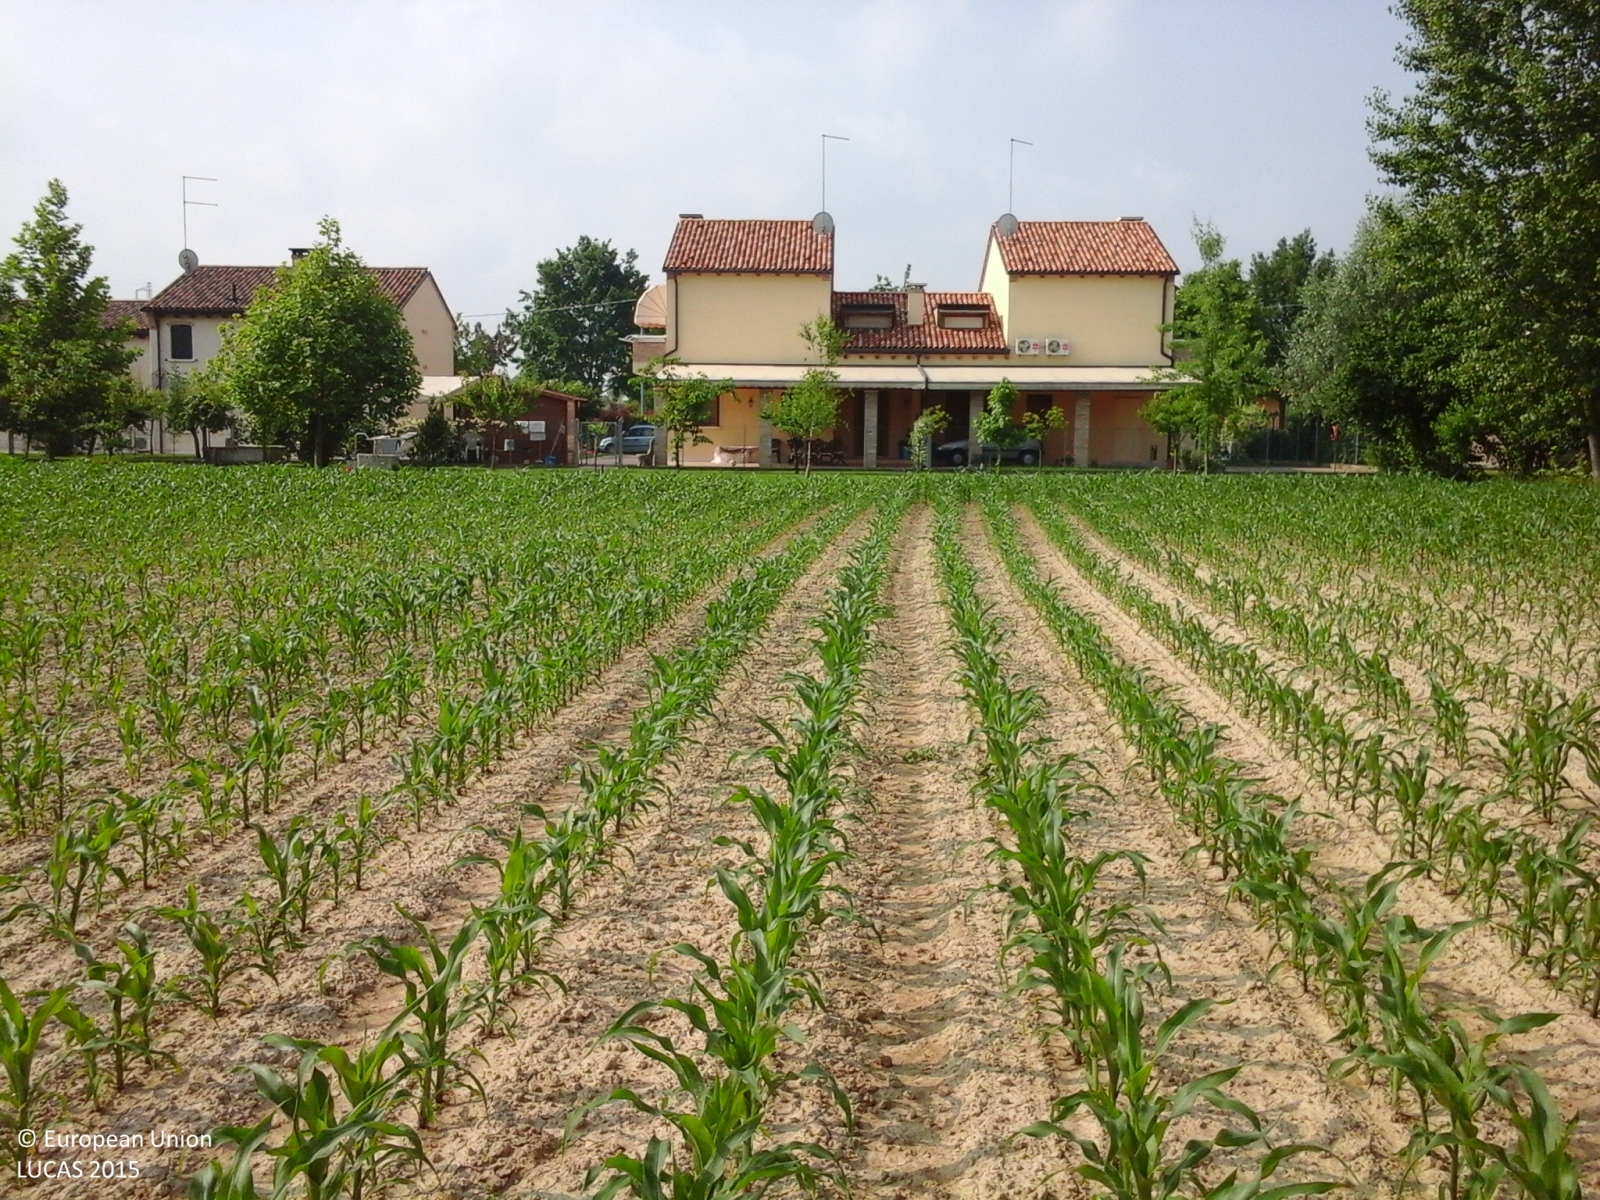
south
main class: Cropland
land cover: Maize
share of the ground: > 75 %
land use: Agriculture (excluding fallow land and kitchen gardens)
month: June
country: IT
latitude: 45.5353
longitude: 12.2120
